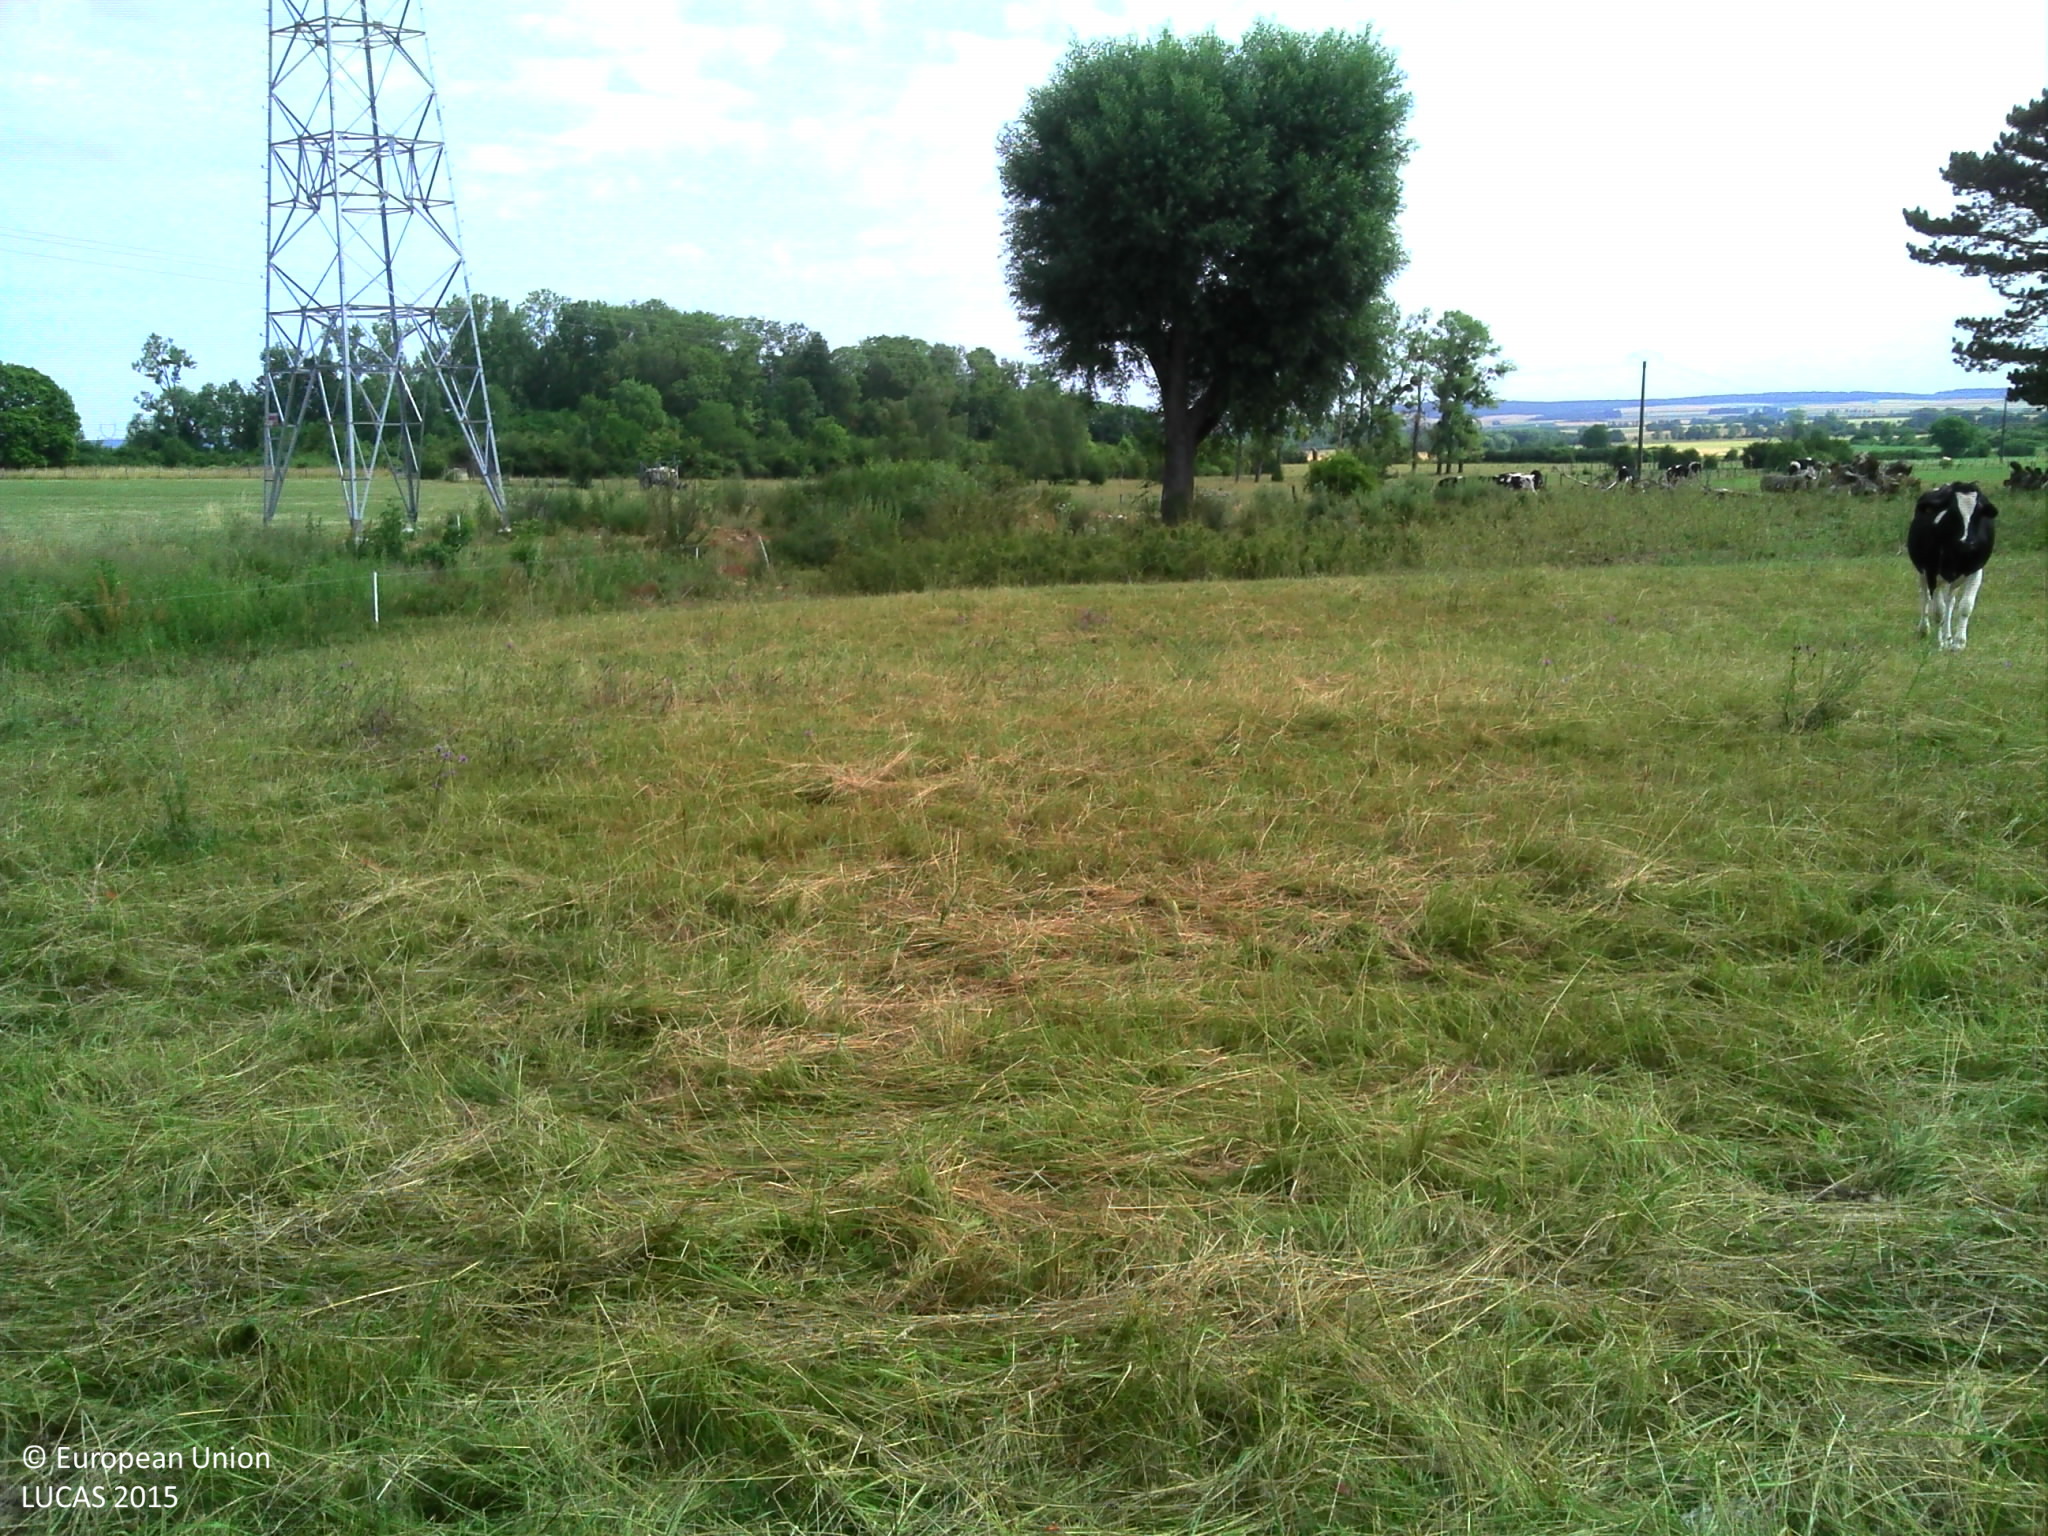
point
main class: Grassland
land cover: Grassland without tree/shrub cover
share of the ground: > 75 %
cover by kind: herbaceous plants 100 %
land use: Agriculture (excluding fallow land and kitchen gardens)
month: June
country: FR
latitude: 48.4795
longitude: 6.1175
